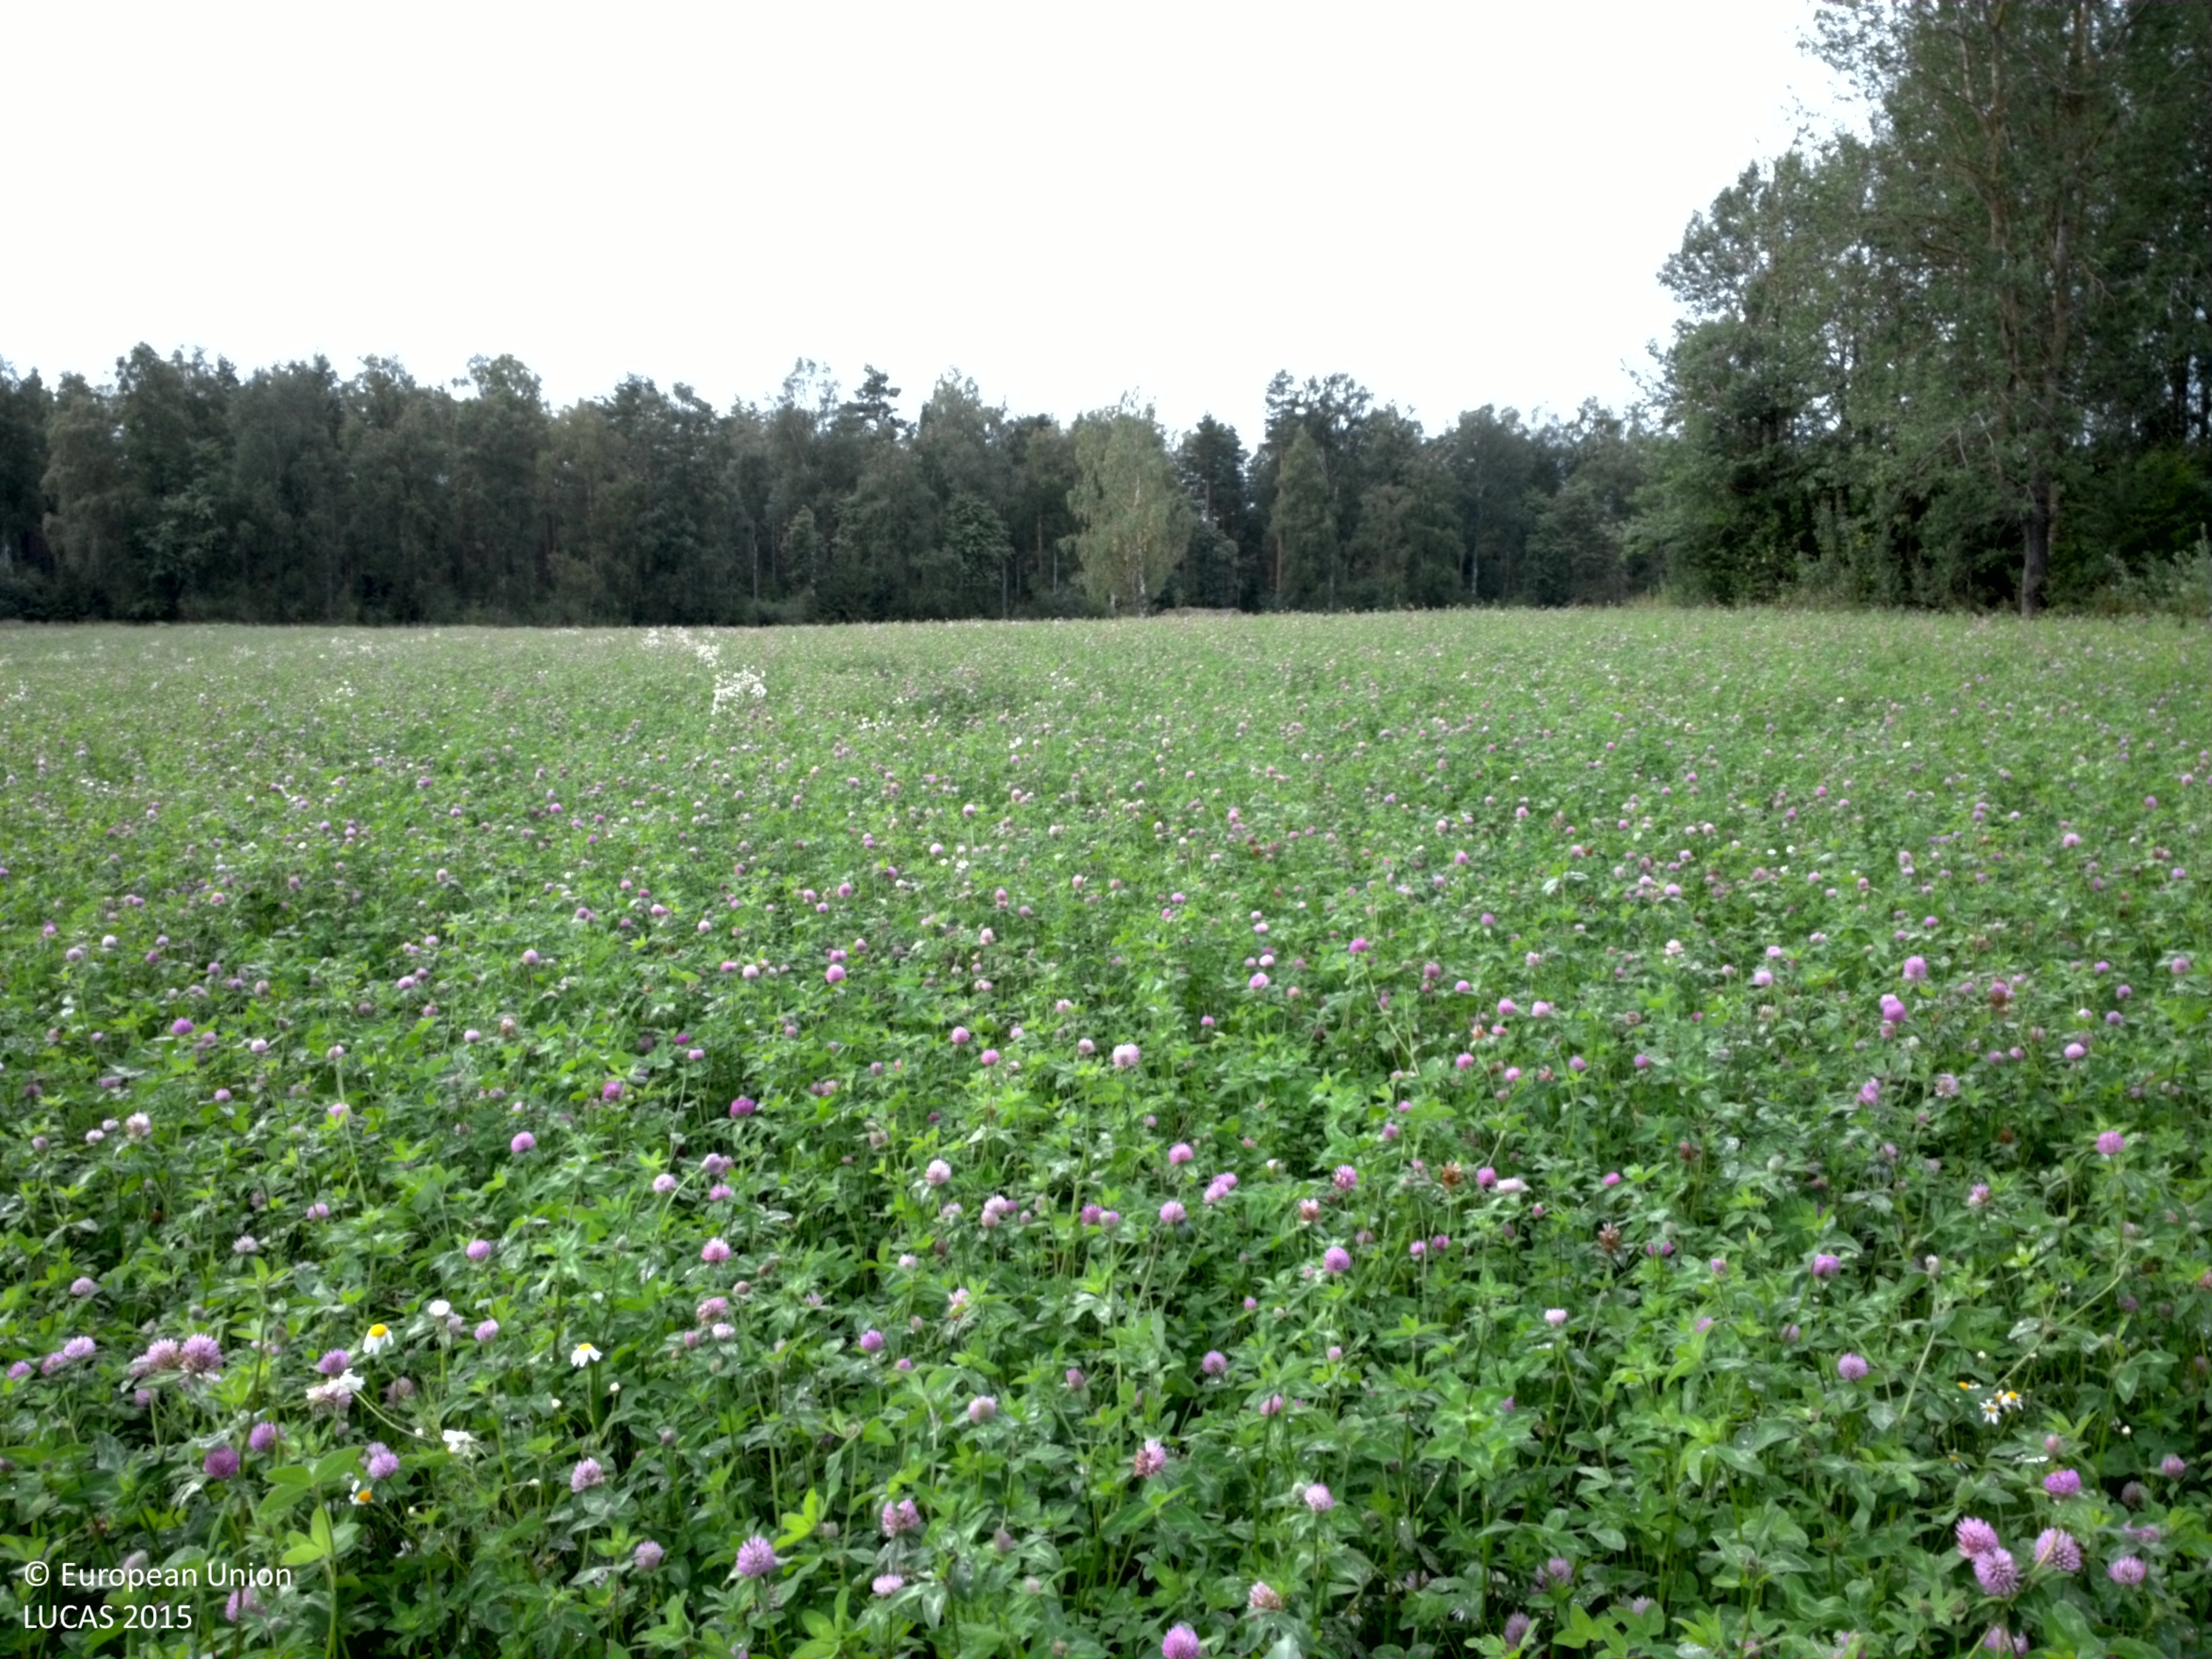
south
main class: Cropland
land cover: Clovers
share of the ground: > 75 %
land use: Agriculture (excluding fallow land and kitchen gardens)
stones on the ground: < 10 %
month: August
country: SE
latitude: 59.9264
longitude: 16.4134
